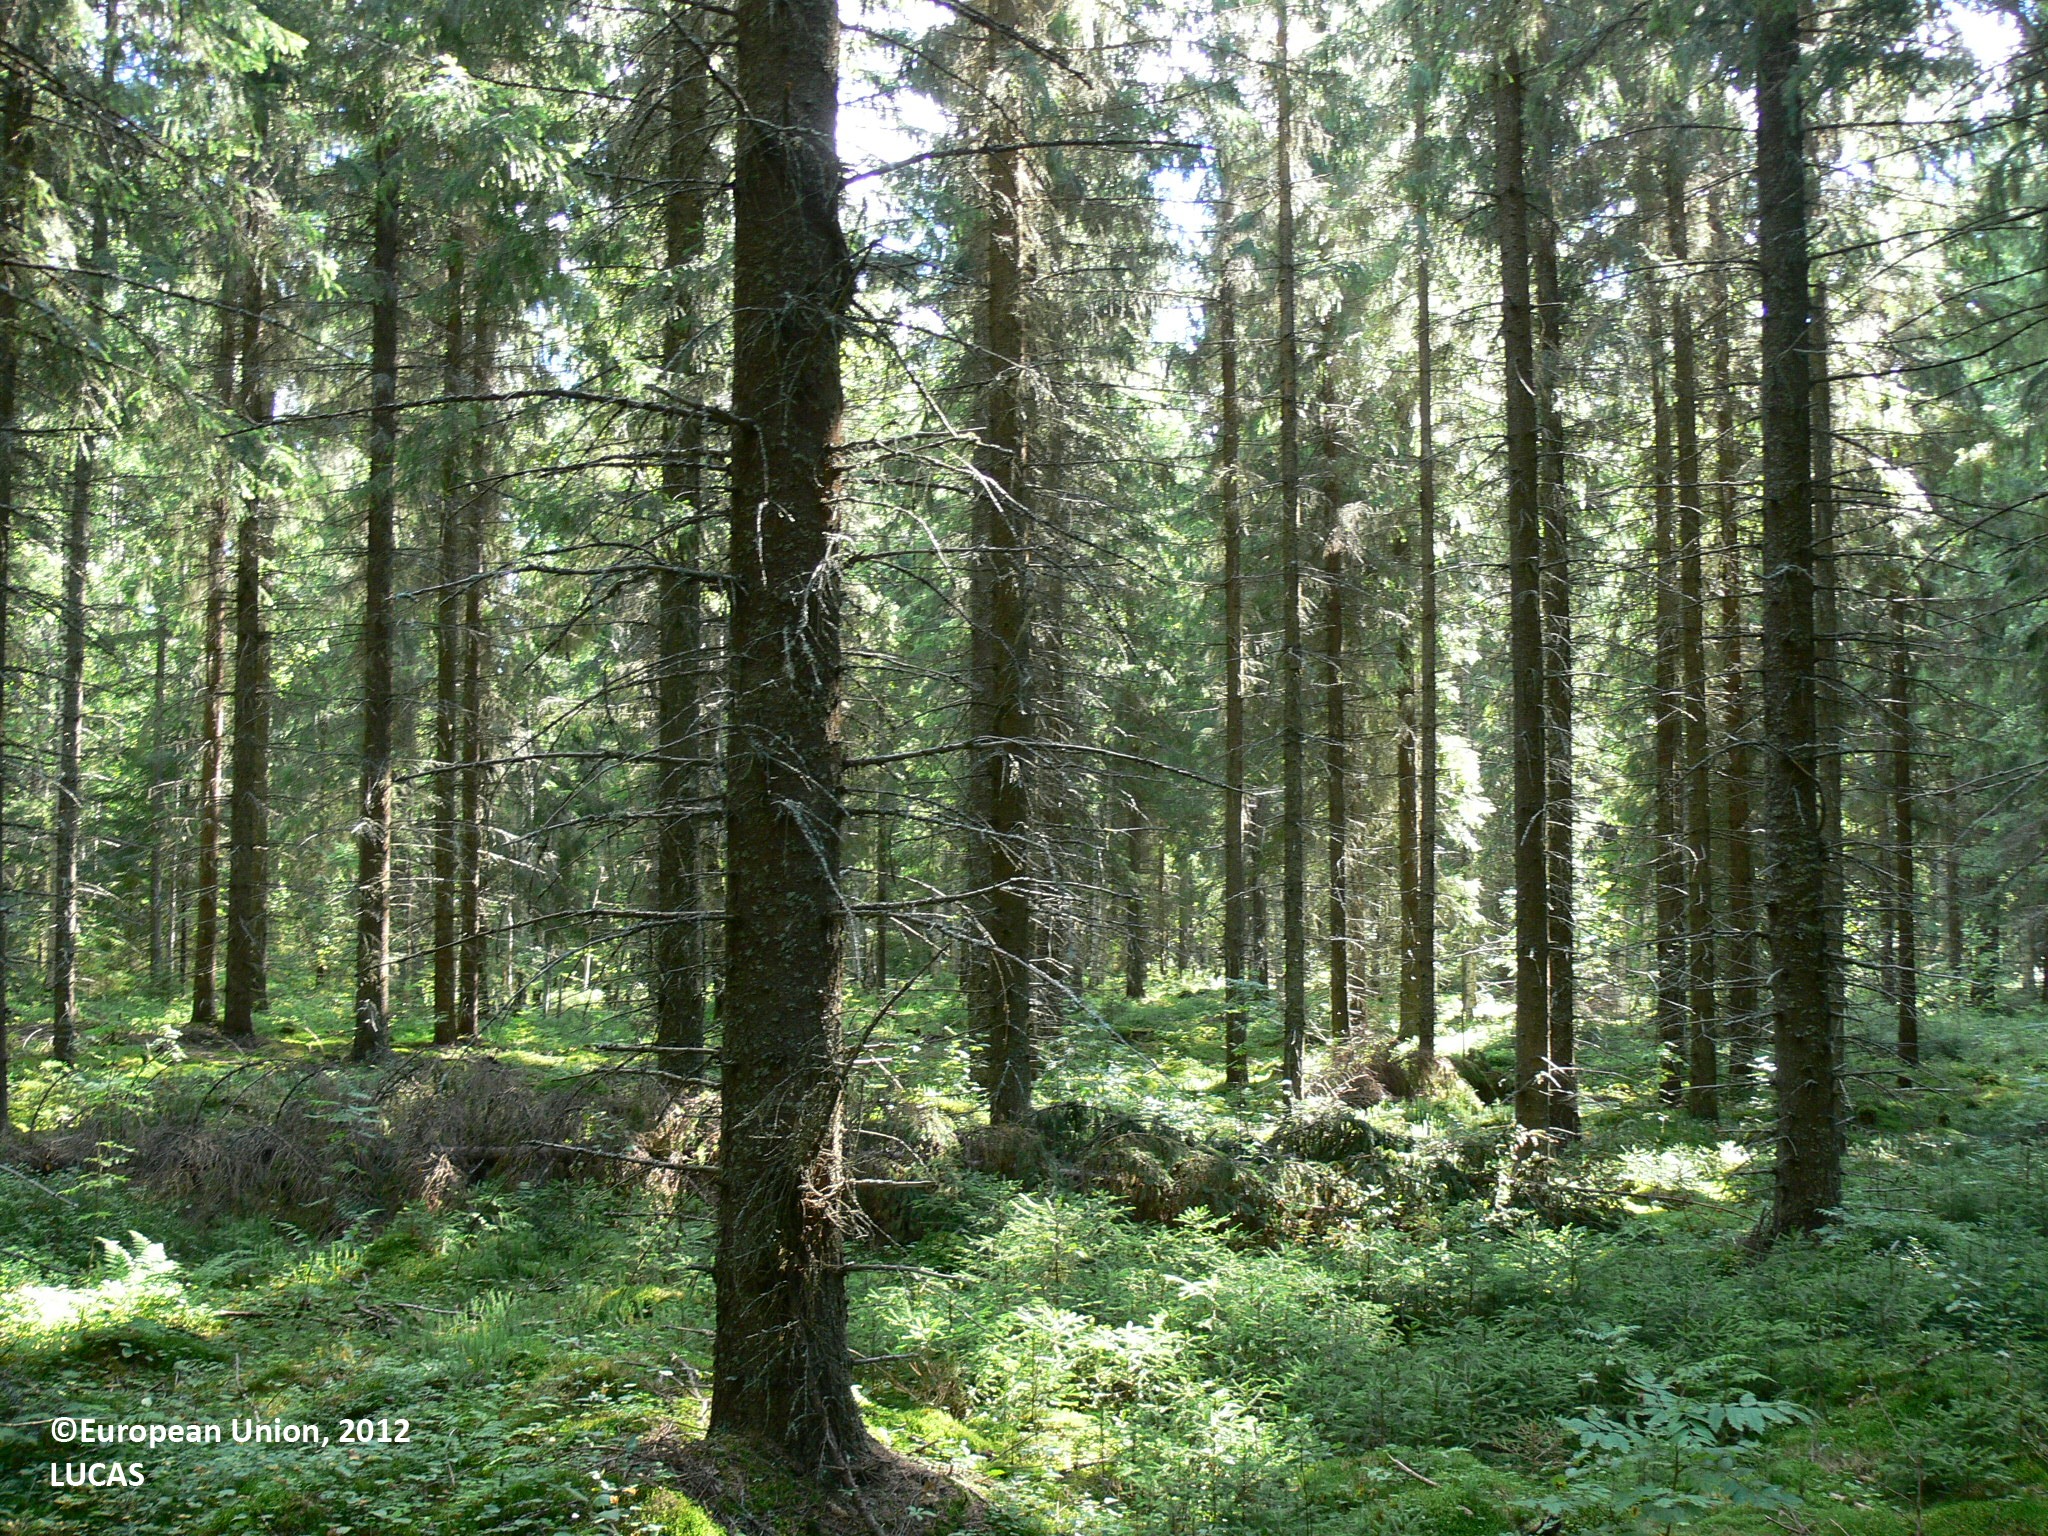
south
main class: Woodland
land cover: Spruce dominated coniferous woodland
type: boreal forest
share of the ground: > 75 %
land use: Forestry
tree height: > 5 m
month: August
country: FI
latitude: 62.0076
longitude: 29.3570
